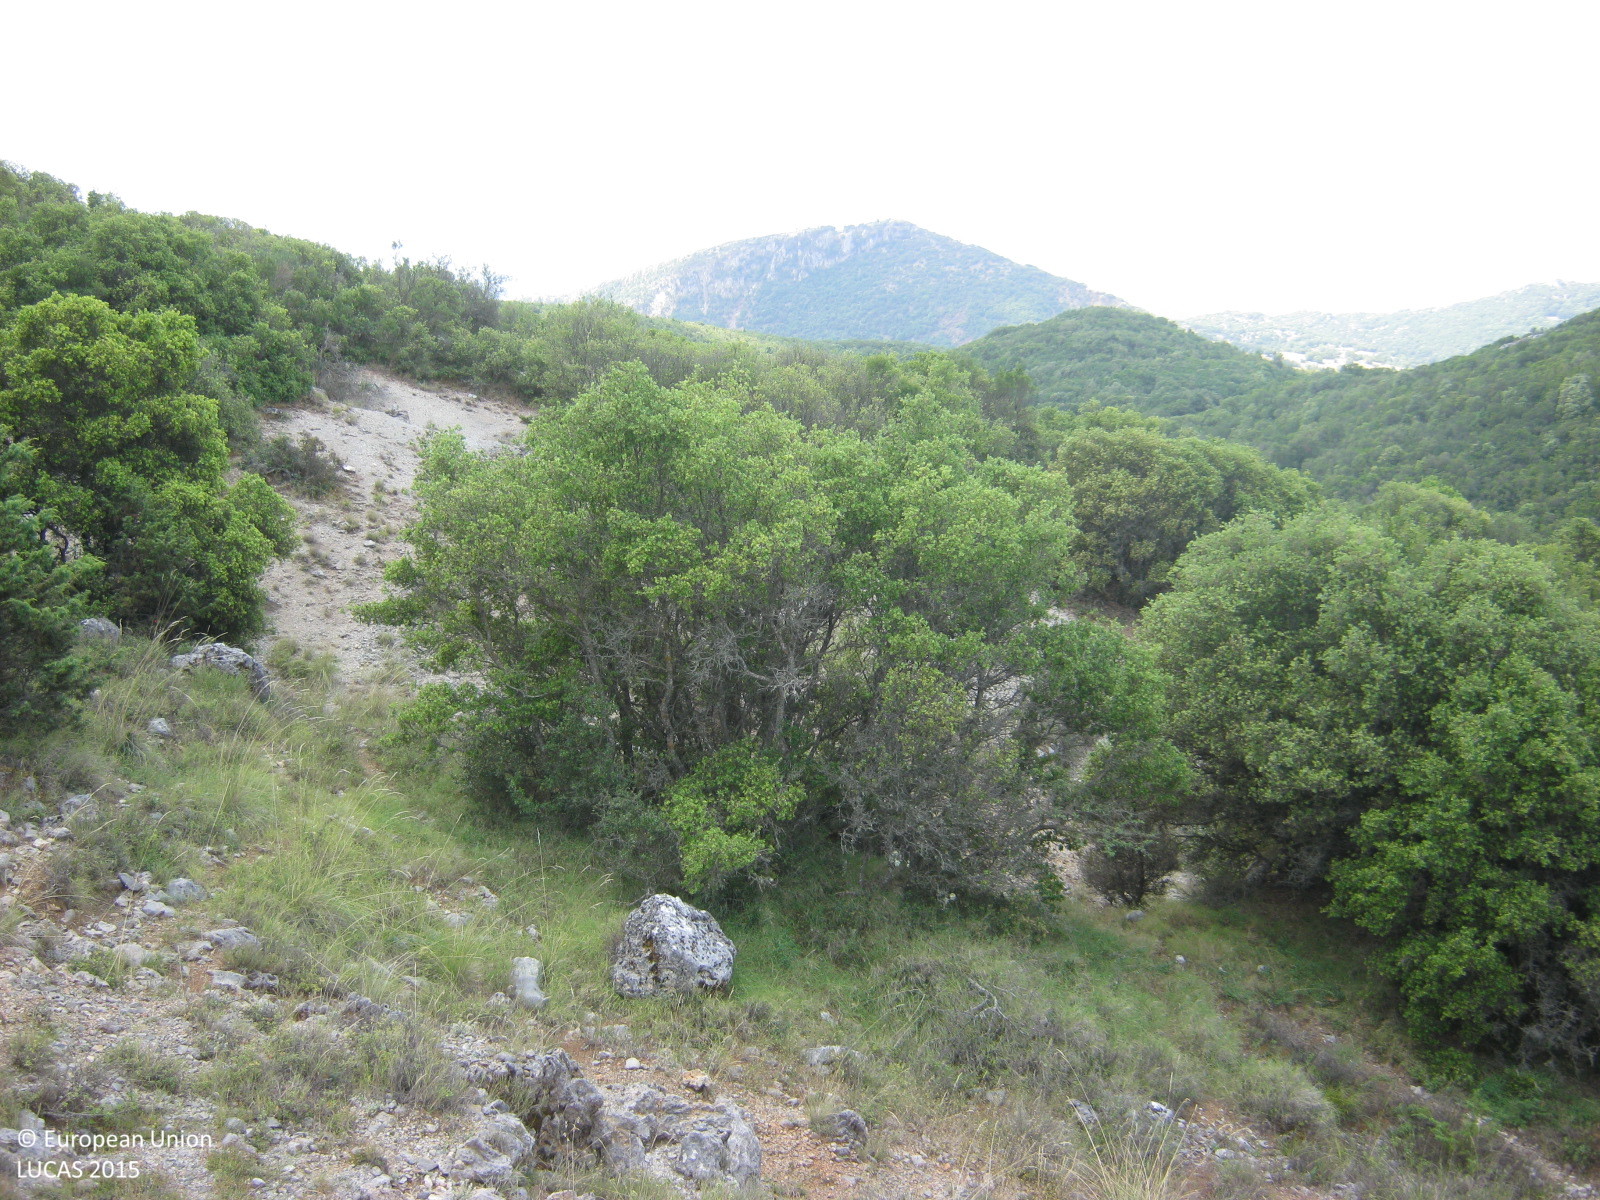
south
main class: Shrubland
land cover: Shrubland with sparse tree cover
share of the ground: > 75 %
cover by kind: shrubs 95 %, broadleaved forest trees 5 %
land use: Semi-natural and natural areas not in use
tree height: < 5 m
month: July
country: GR
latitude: 37.7568
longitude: 22.1200
